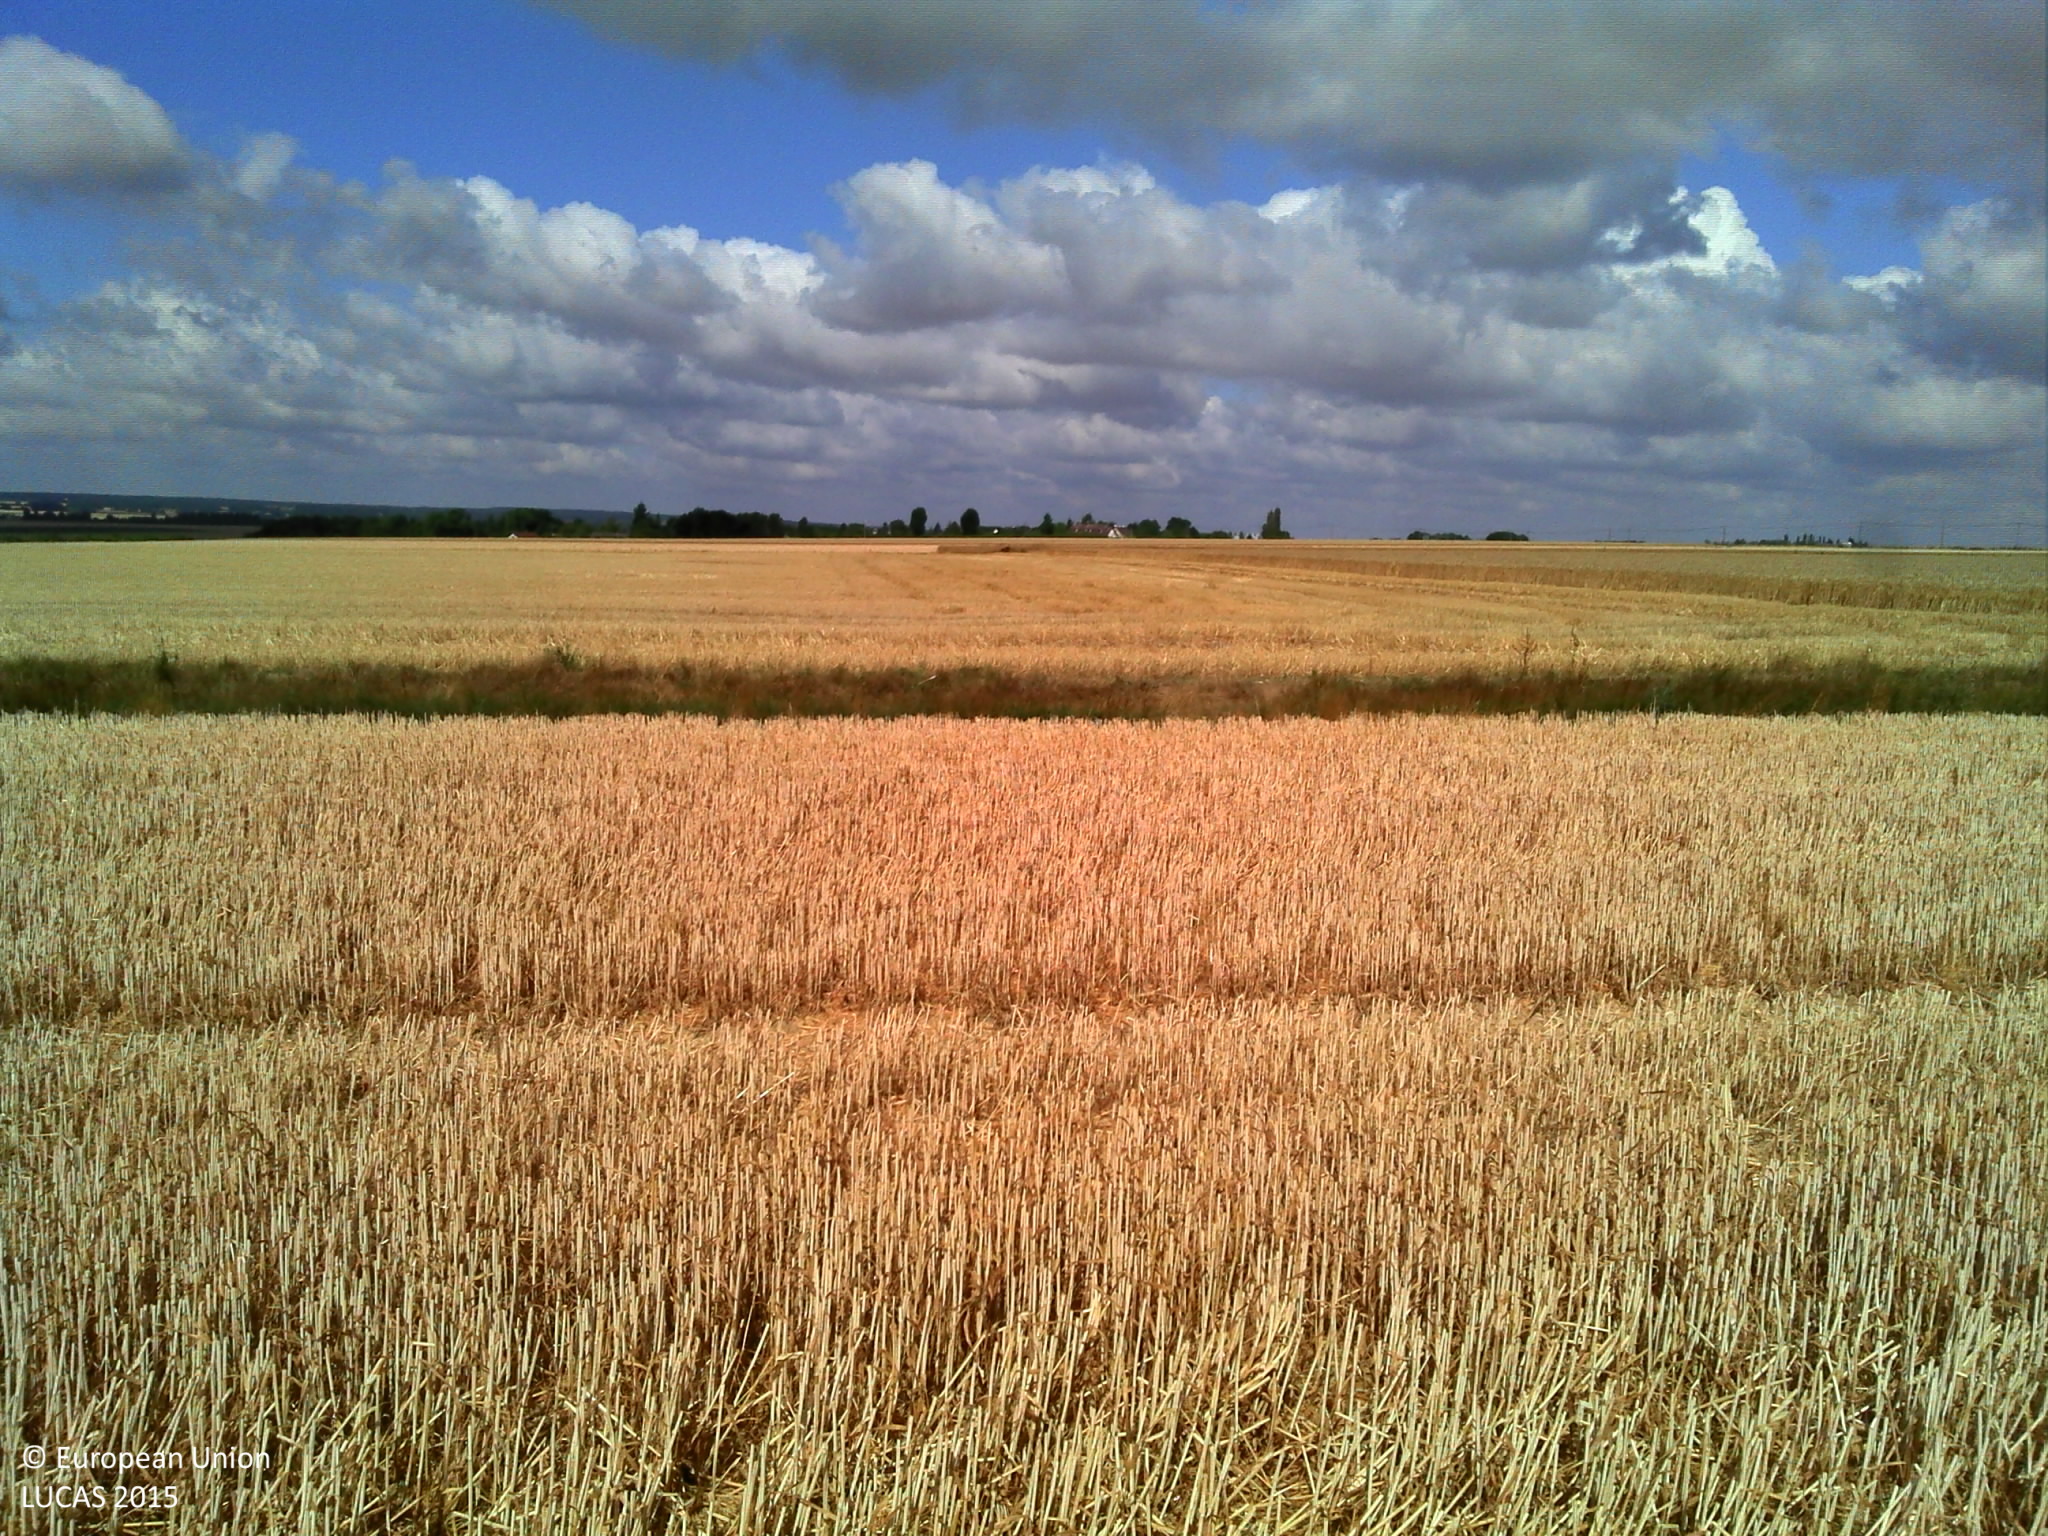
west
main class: Cropland
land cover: Common wheat
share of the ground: > 75 %
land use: Agriculture (excluding fallow land and kitchen gardens)
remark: Harvested field
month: July
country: FR
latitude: 48.5243
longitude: 1.2206
